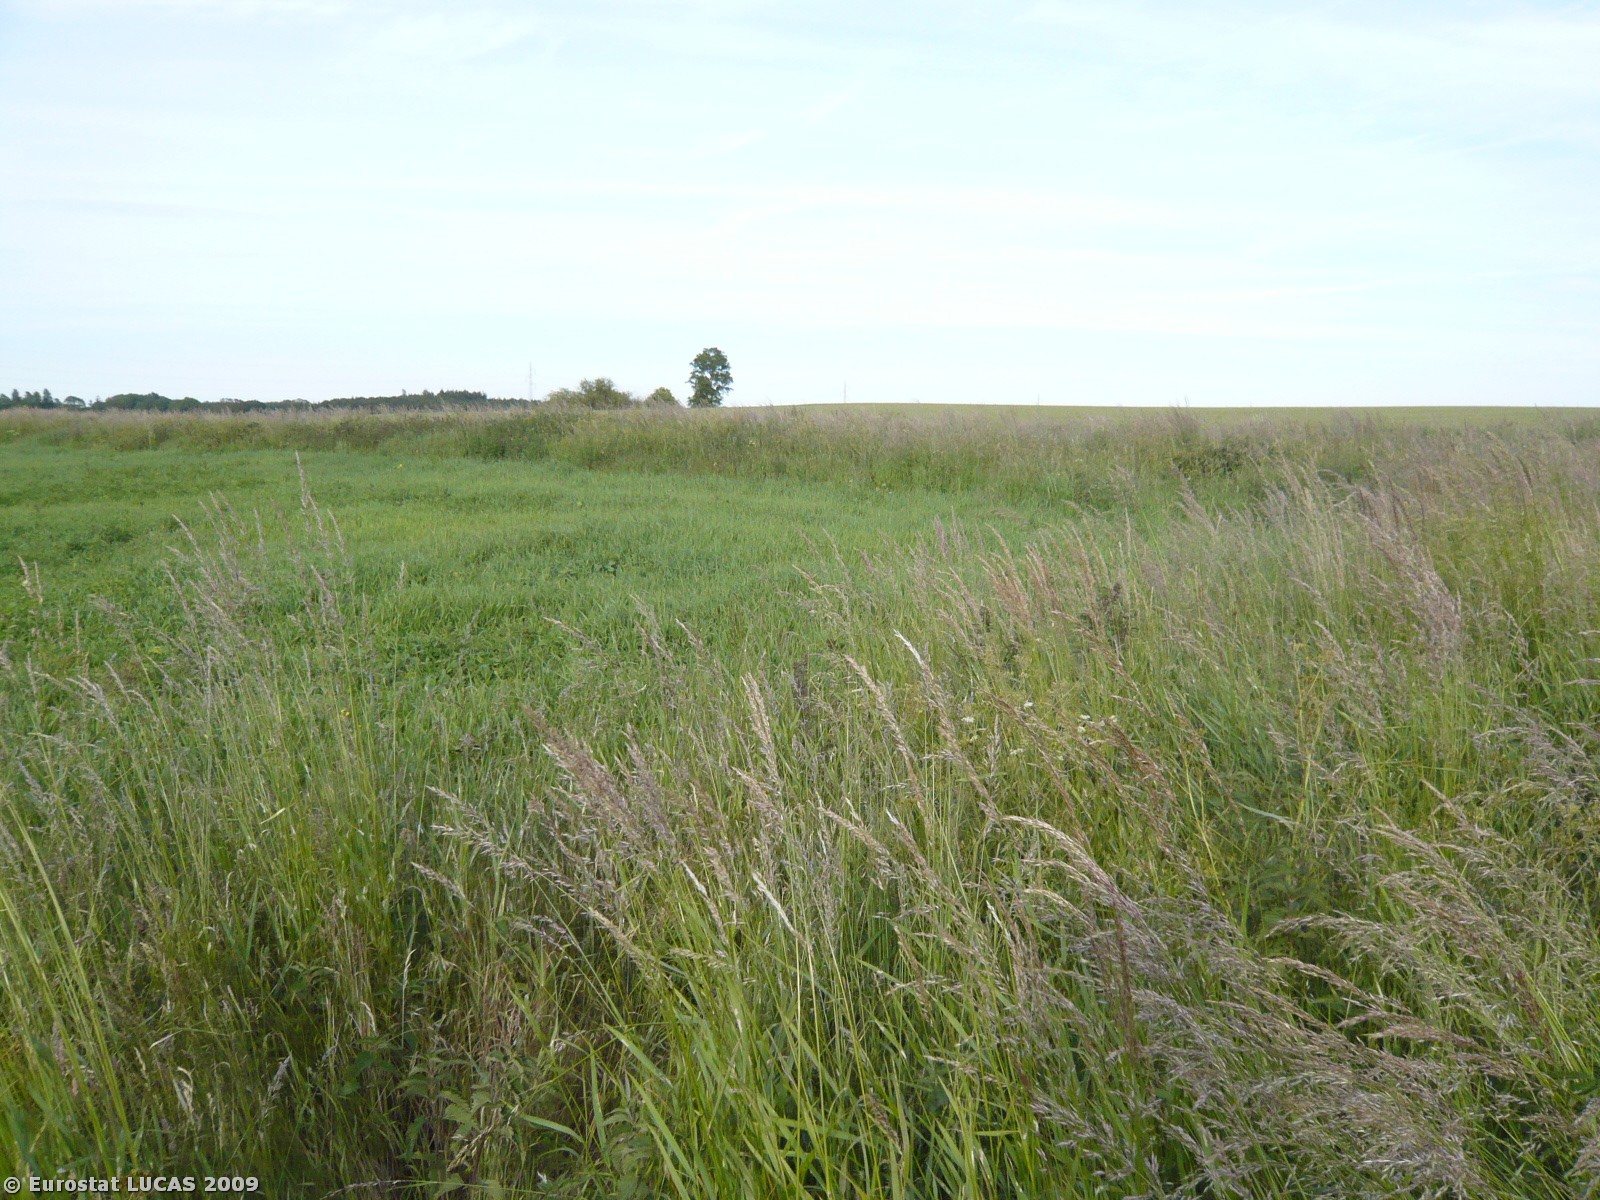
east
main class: Grassland
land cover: Grassland without tree/shrub cover
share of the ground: > 75 %
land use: Unused
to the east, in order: Grassland without tree/shrub cover; Spontaneously vegetated surfaces; Grassland without tree/shrub cover; Inland running water; Shruby margins; Common wheat
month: June
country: DK
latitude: 54.8340
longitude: 11.1979
